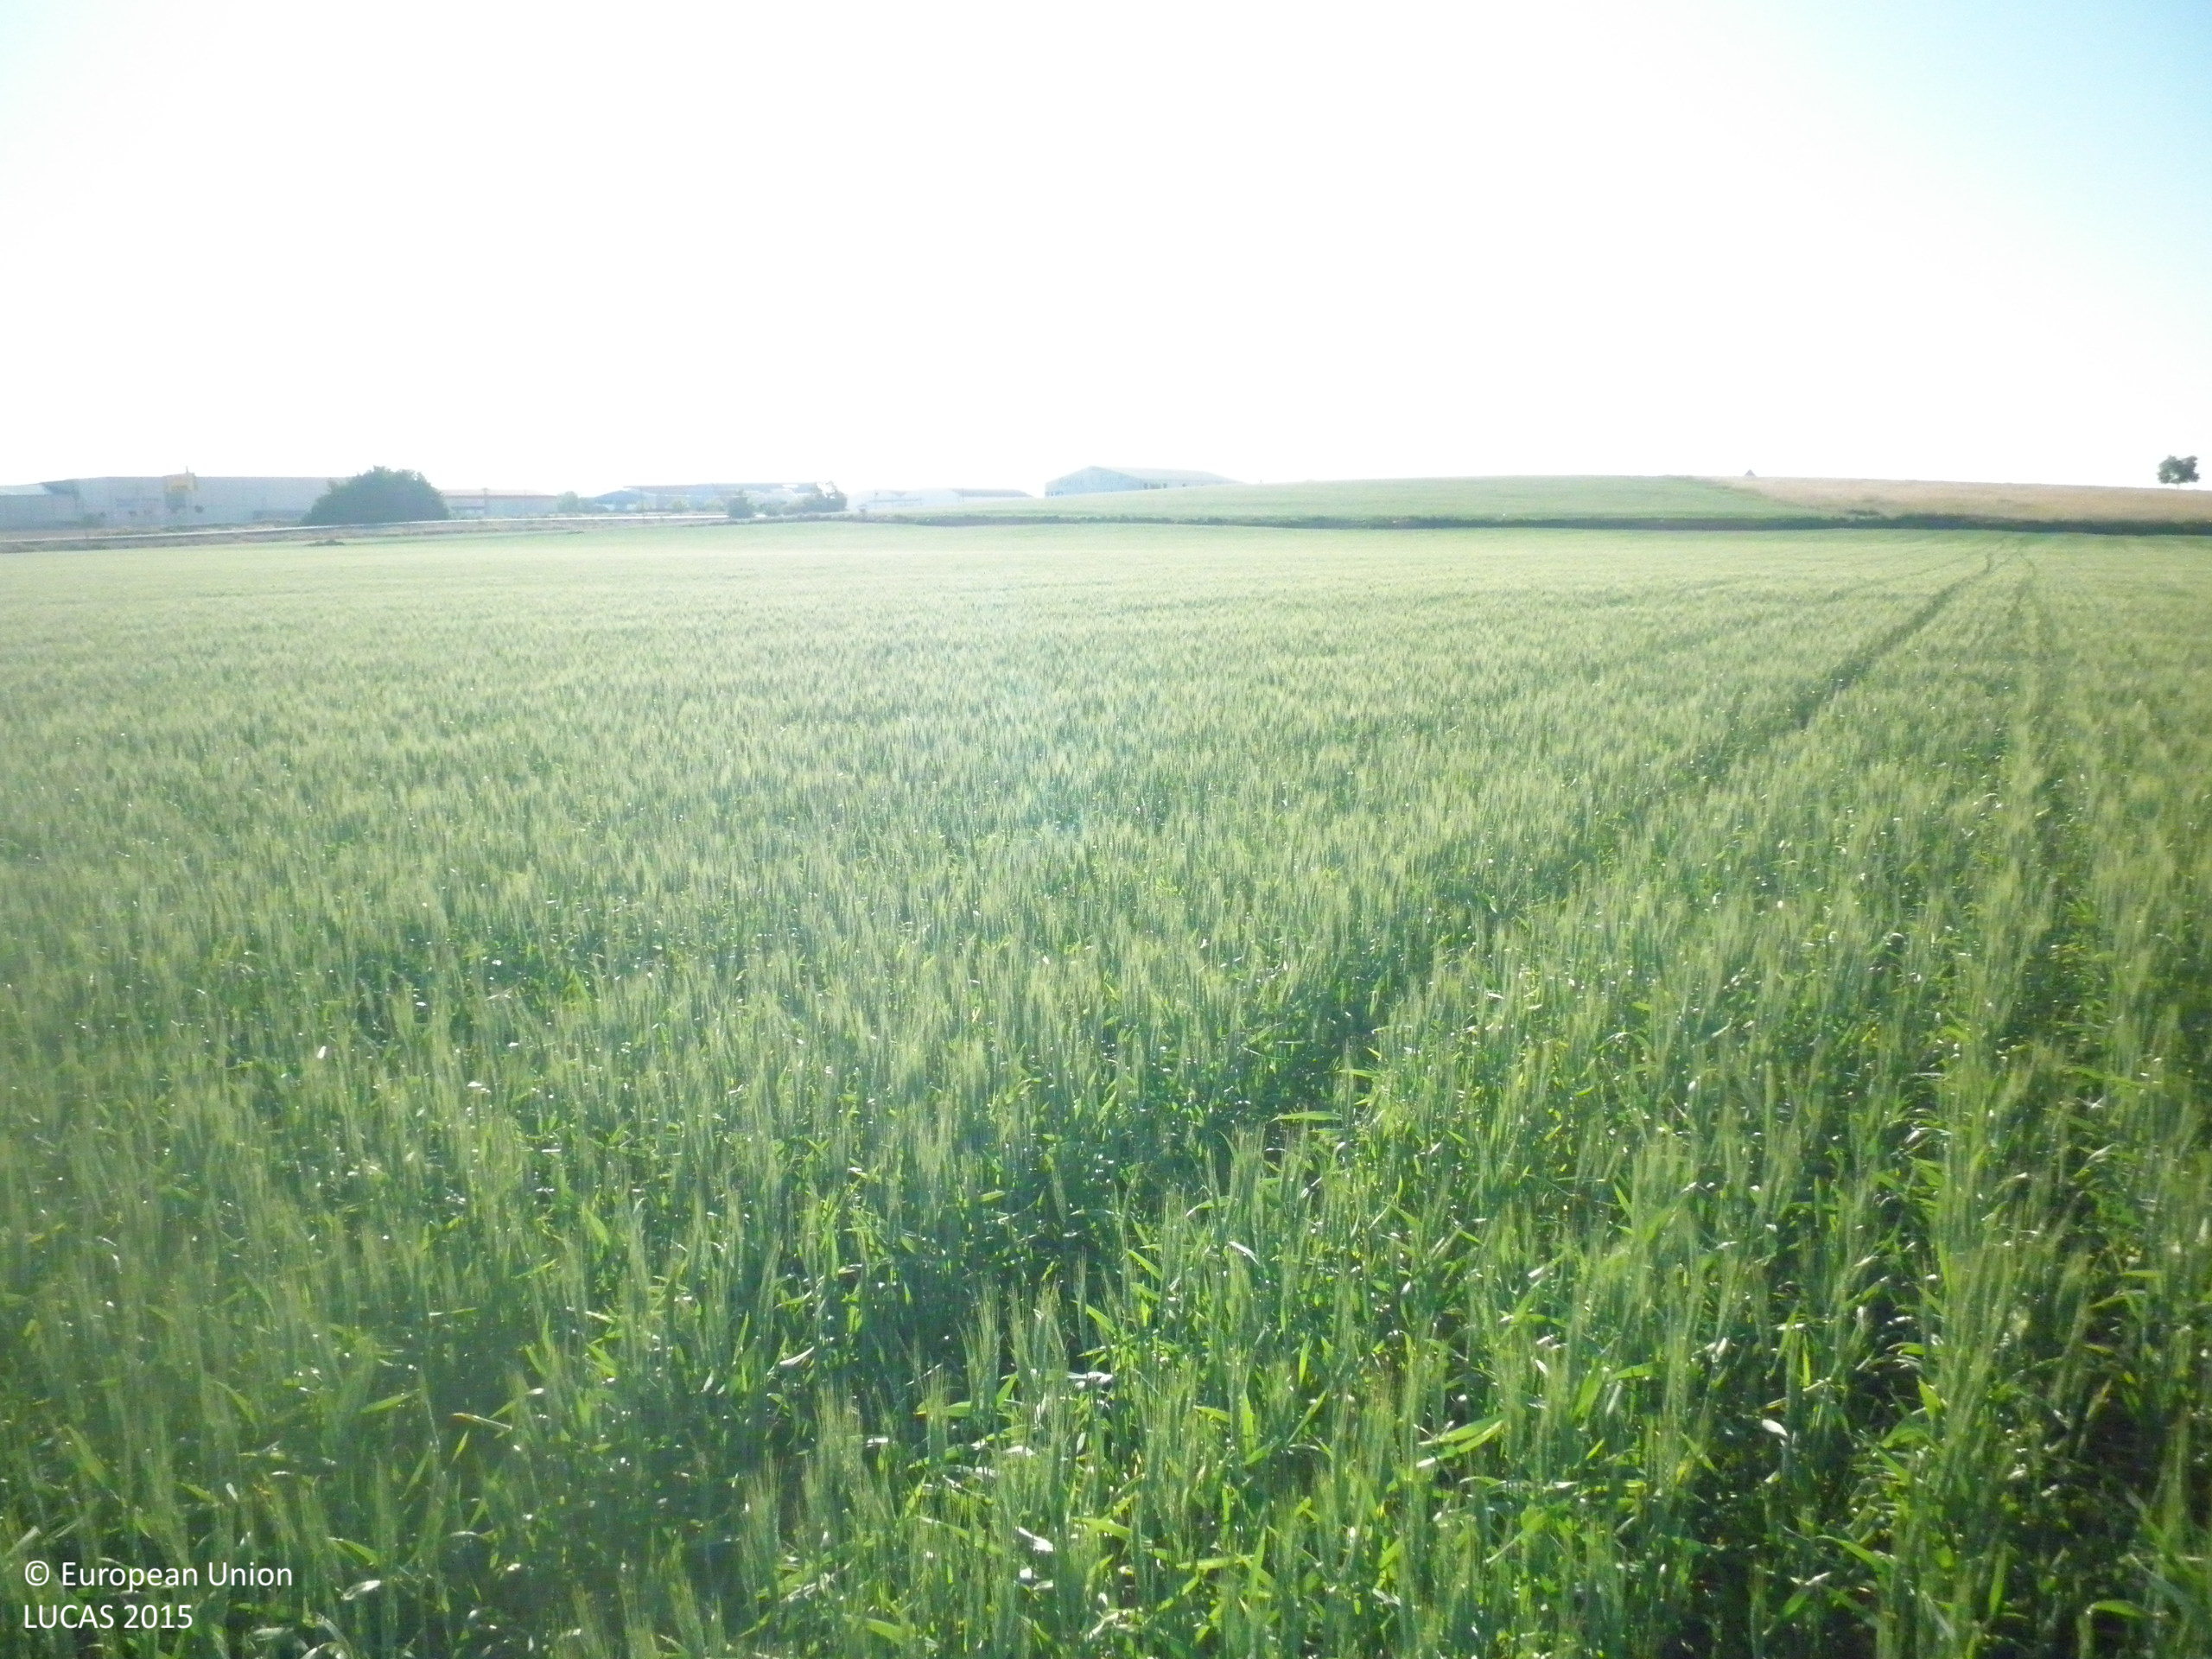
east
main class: Cropland
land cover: Durum wheat
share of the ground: > 75 %
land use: Agriculture (excluding fallow land and kitchen gardens)
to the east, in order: Durum wheat; Grass margins; Durum wheat
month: May
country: ES
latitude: 39.4576
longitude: -2.6929
